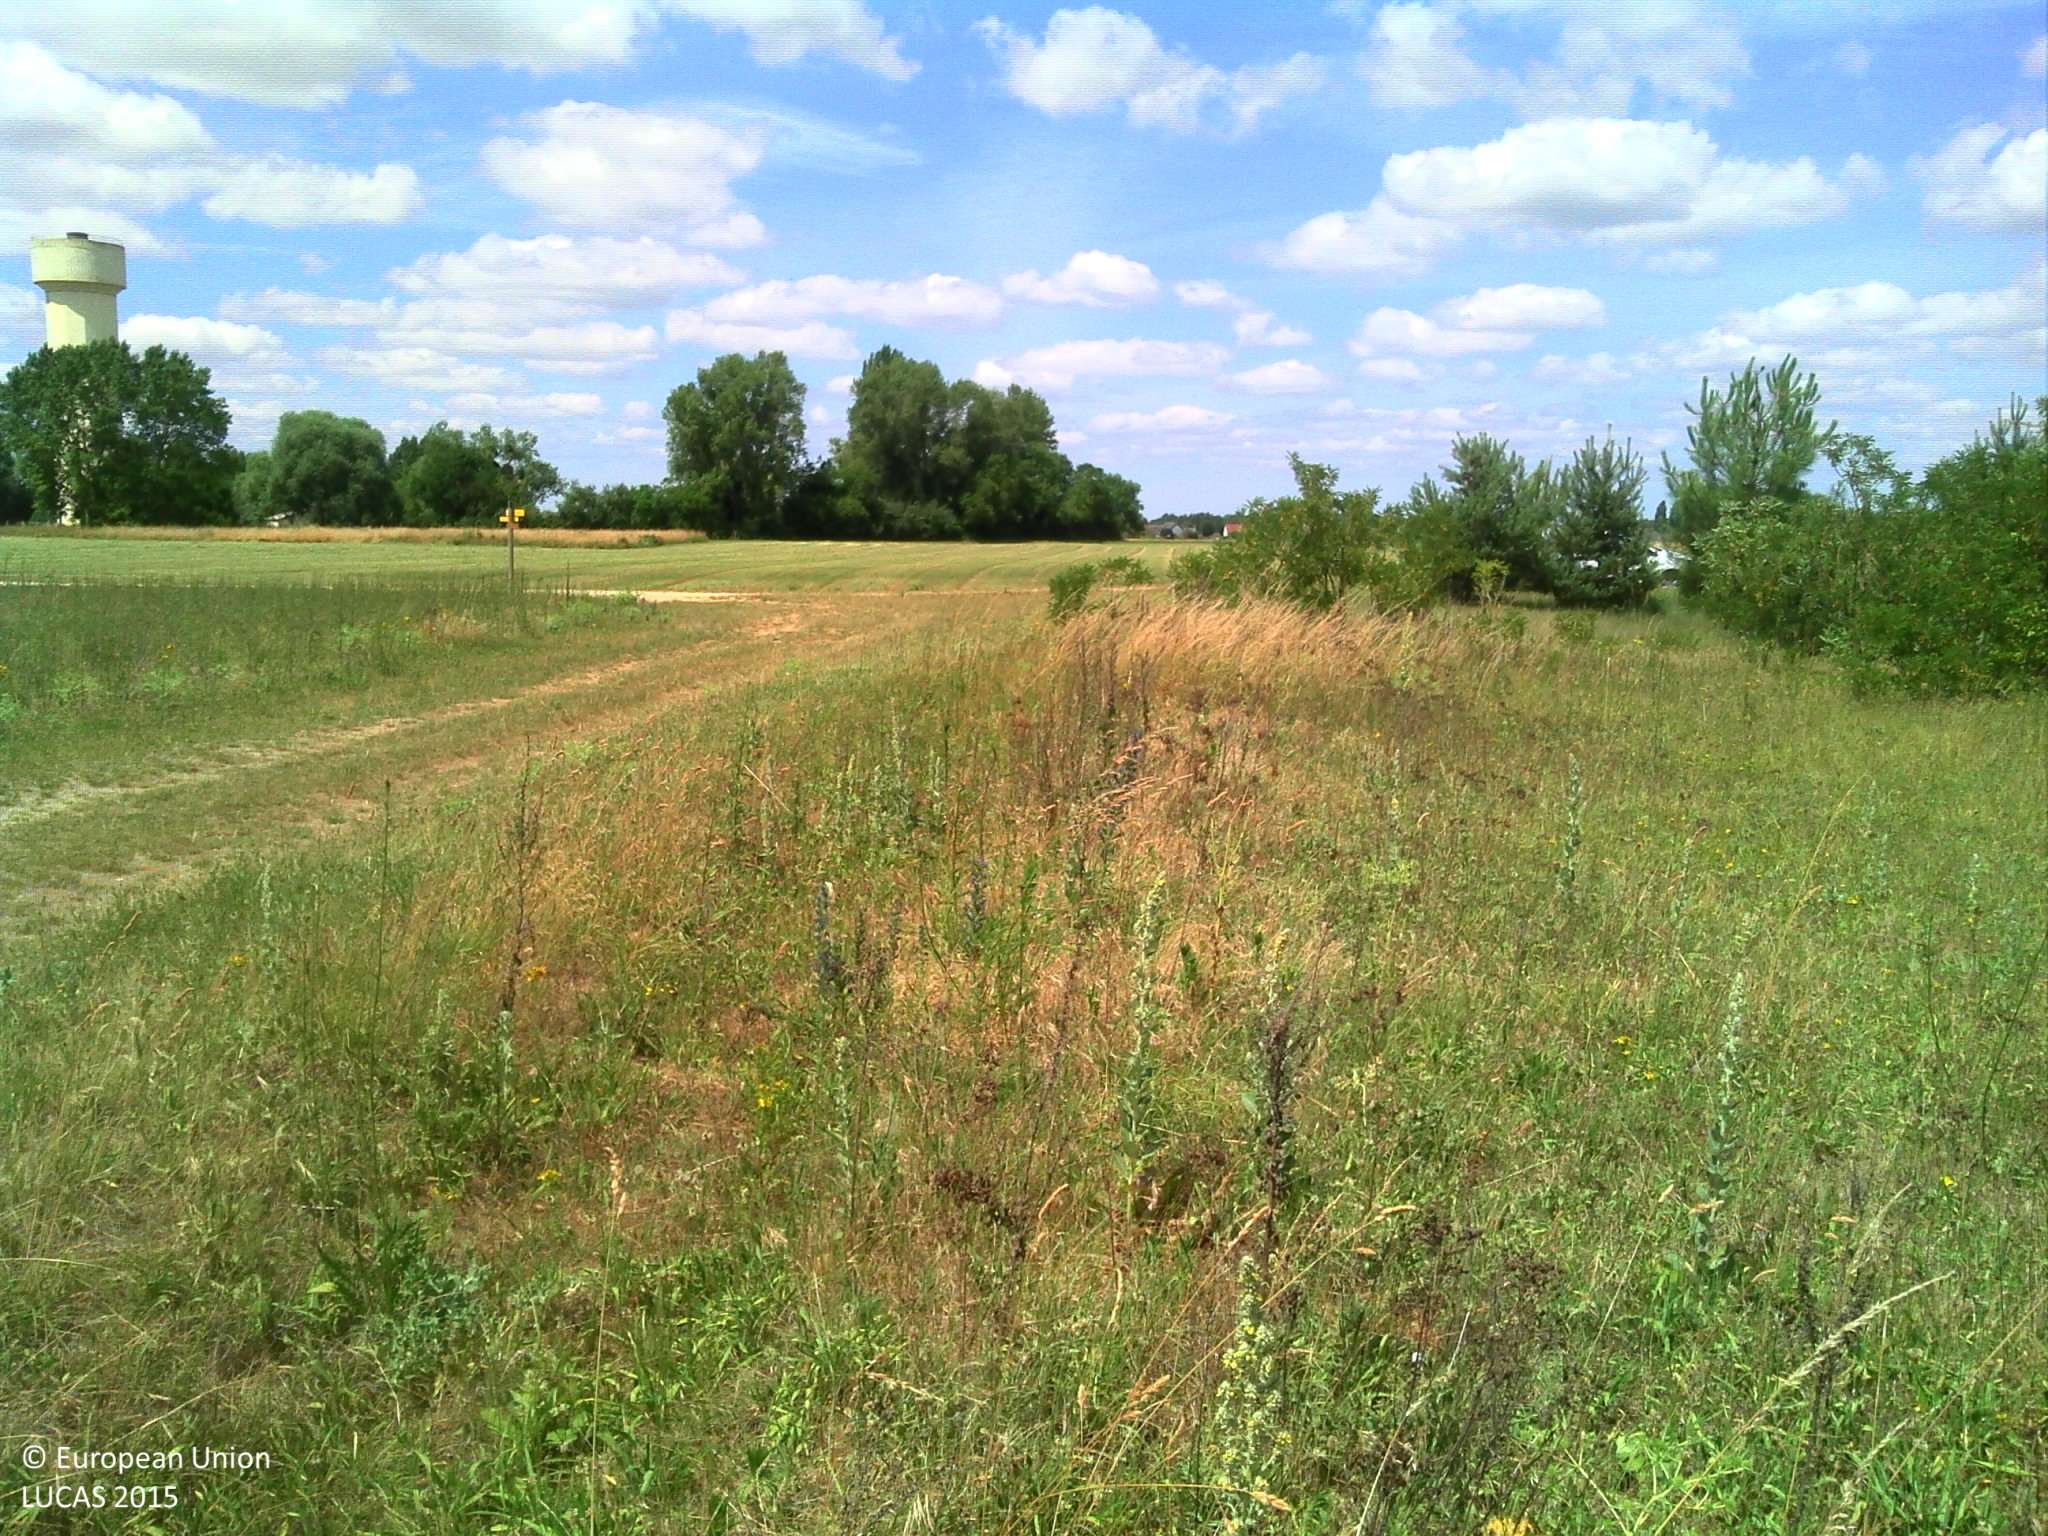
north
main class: Grassland
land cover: Grassland without tree/shrub cover
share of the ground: > 75 %
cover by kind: herbaceous plants 100 %
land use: Agriculture (excluding fallow land and kitchen gardens)
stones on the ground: < 10 %
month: June
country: FR
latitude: 47.4334
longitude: 0.3117
